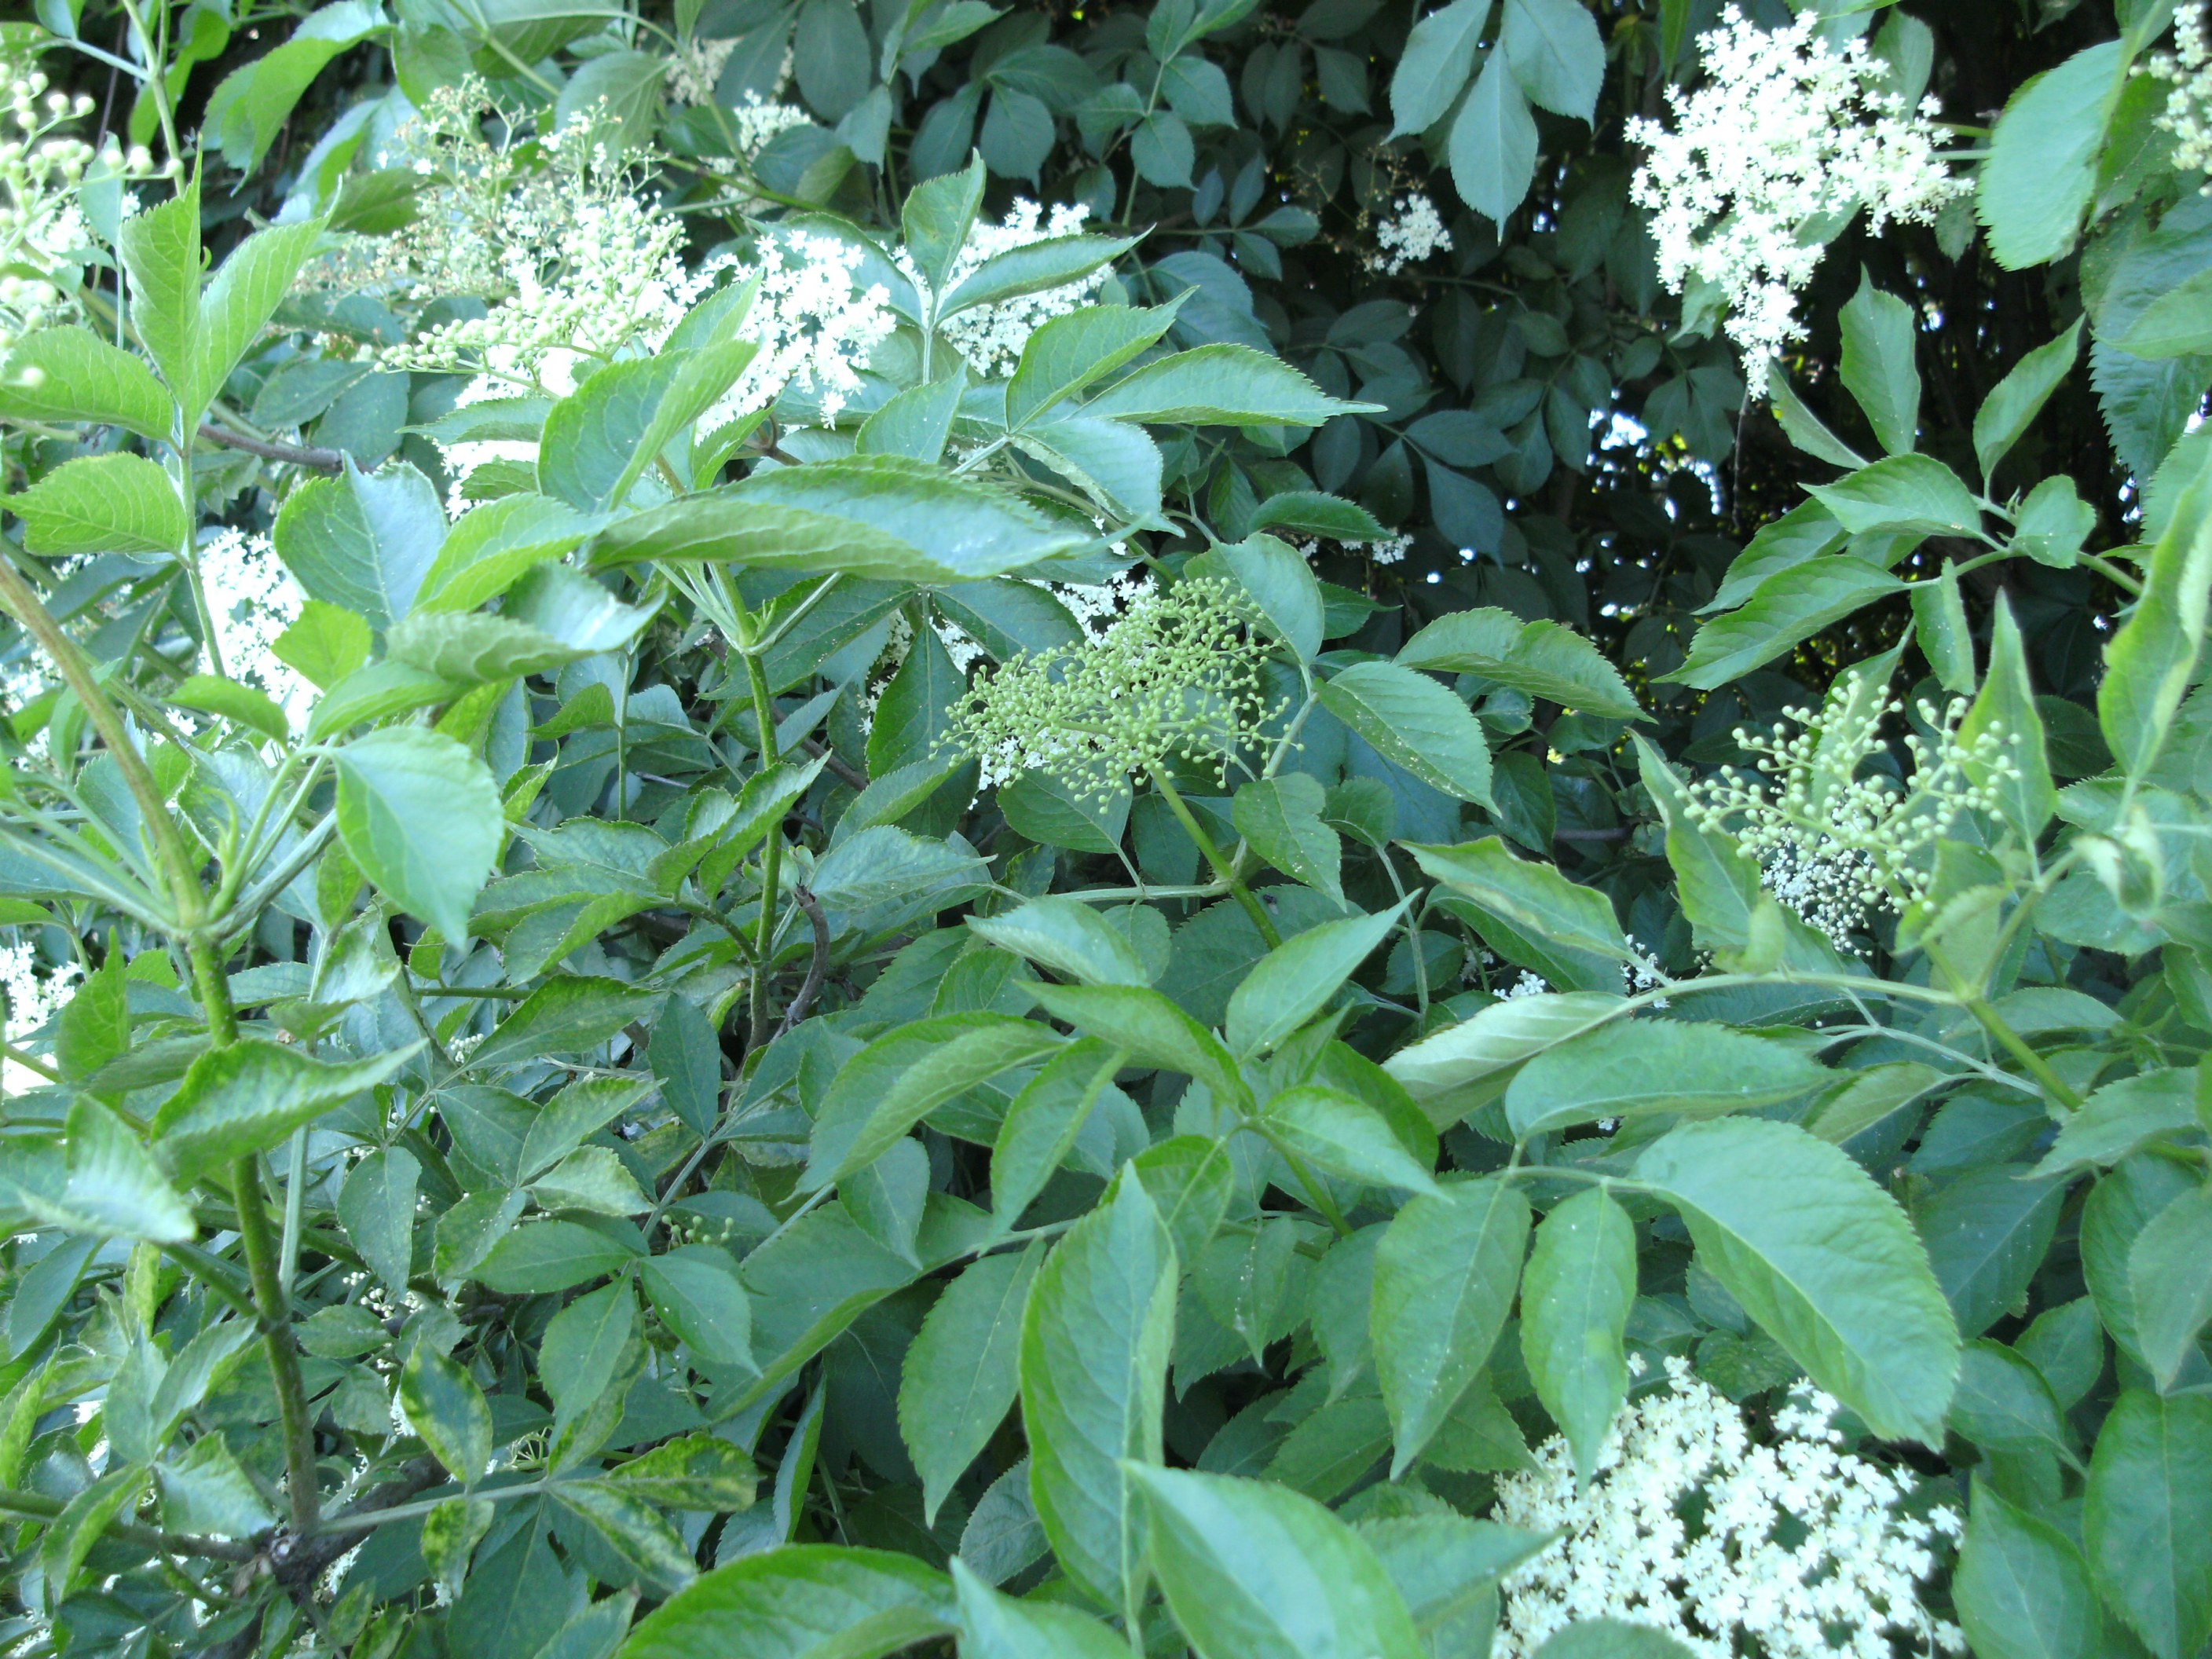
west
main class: Cropland
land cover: Common wheat
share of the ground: > 75 %
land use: Agriculture (excluding fallow land and kitchen gardens)
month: June
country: AT
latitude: 48.2352
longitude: 14.1602
